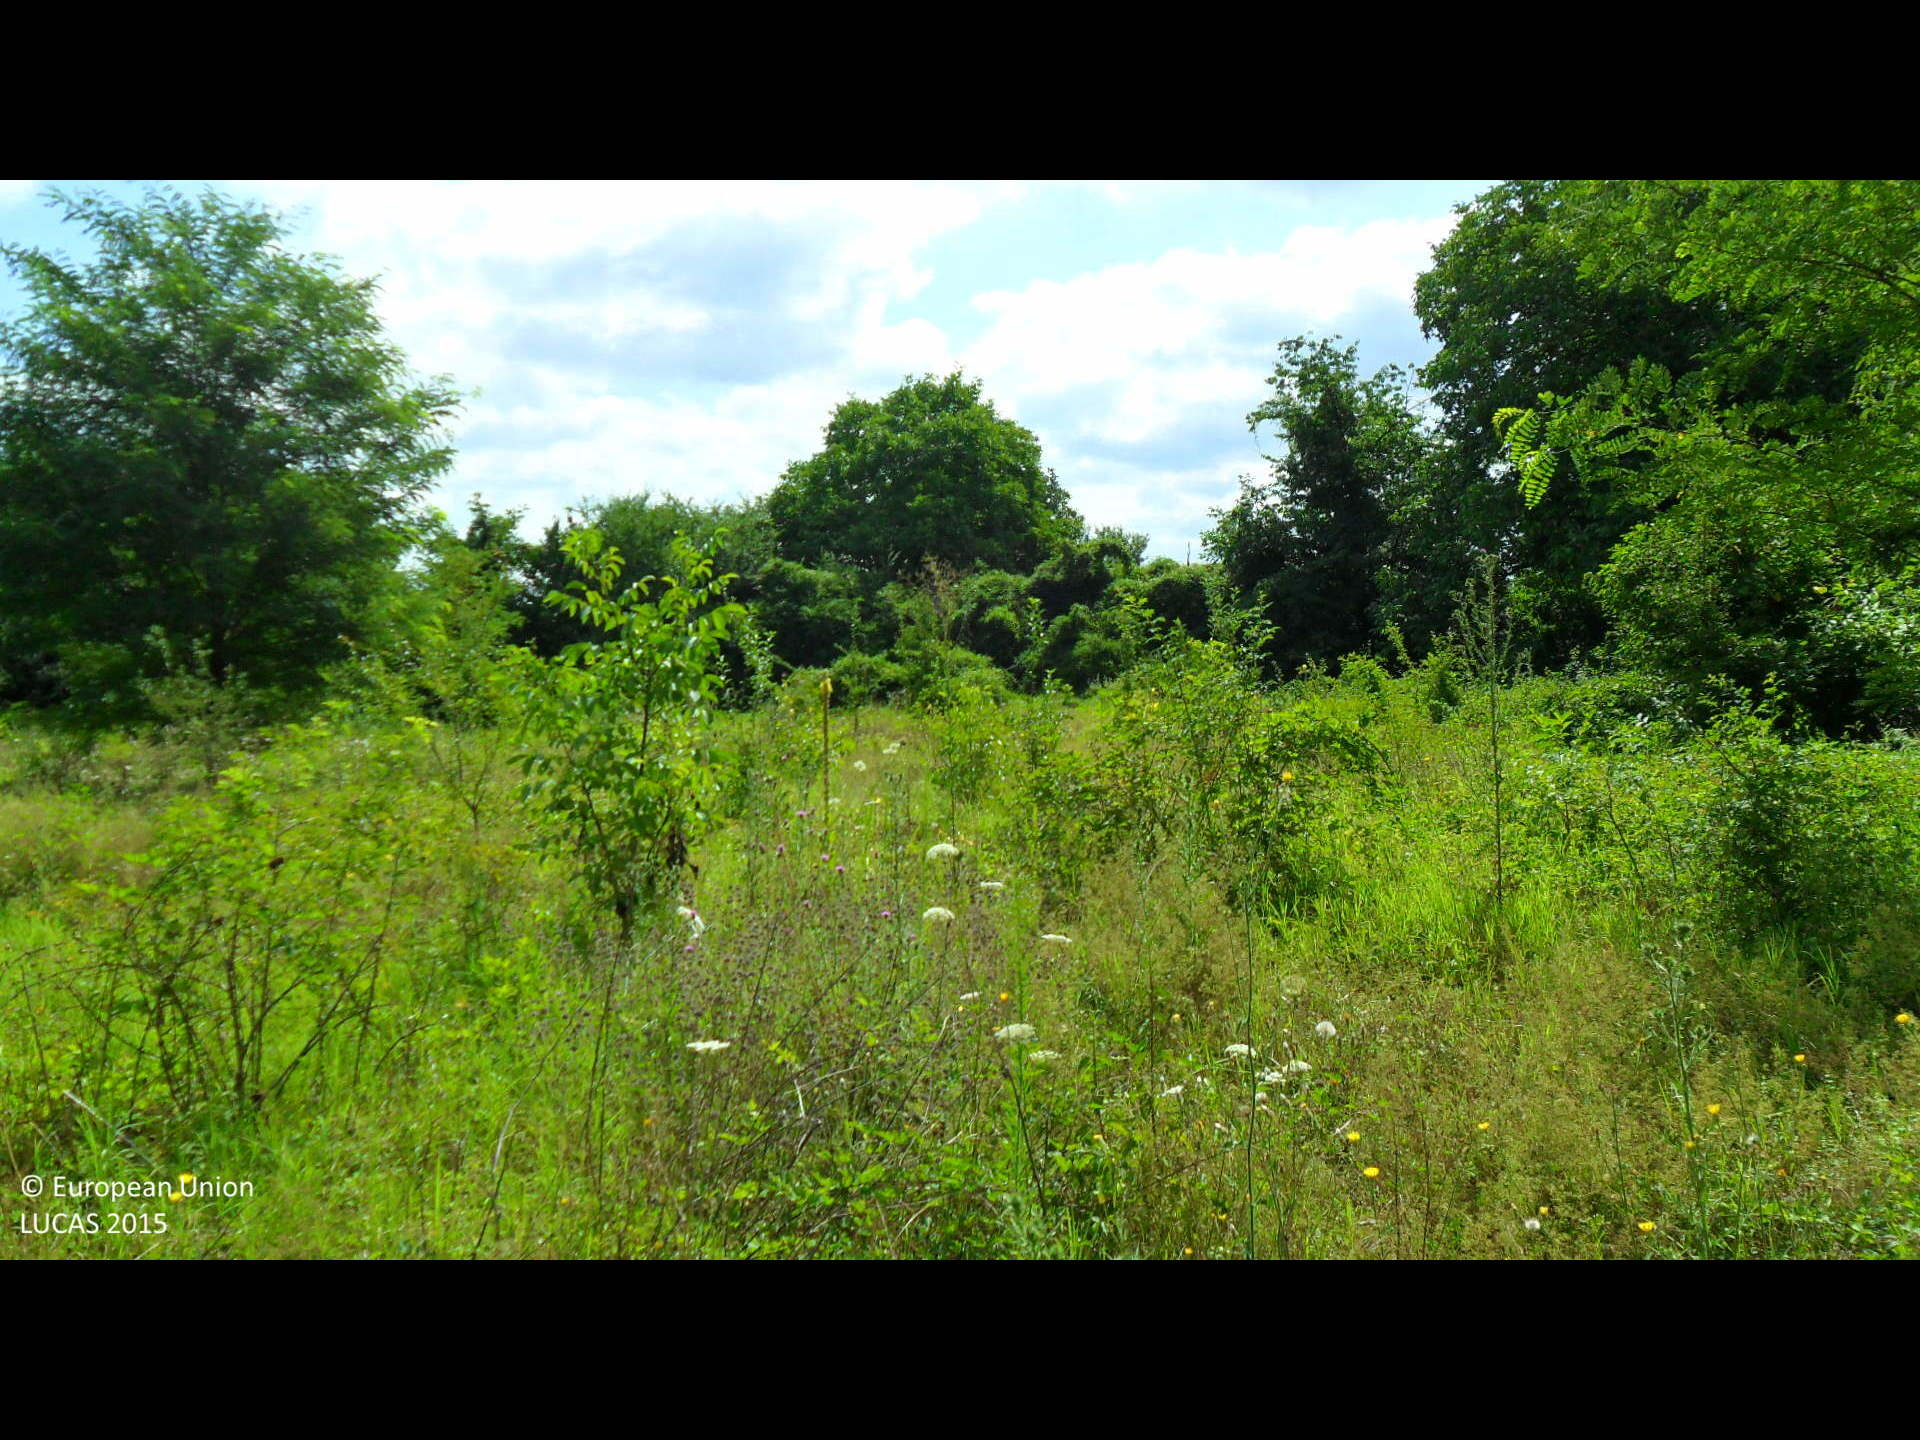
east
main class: Woodland
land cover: Broadleaved woodland
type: mesophytic deciduous forest
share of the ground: 50 - 75 %
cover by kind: broadleaved forest trees 50 %, herbaceous plants 30 %, shrubs 20 %
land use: Residential
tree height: < 5 m
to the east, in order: Broadleaved woodland; Grassland with sparse tree/shrub cover; Broadleaved woodland; Grassland without tree/shrub cover; Shrubland with sparse tree cover; Grassland without tree/shrub cover; Artificial constructions in urban areas; Grassland without tree/shrub cover
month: August
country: BG
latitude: 43.4299
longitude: 26.3445
